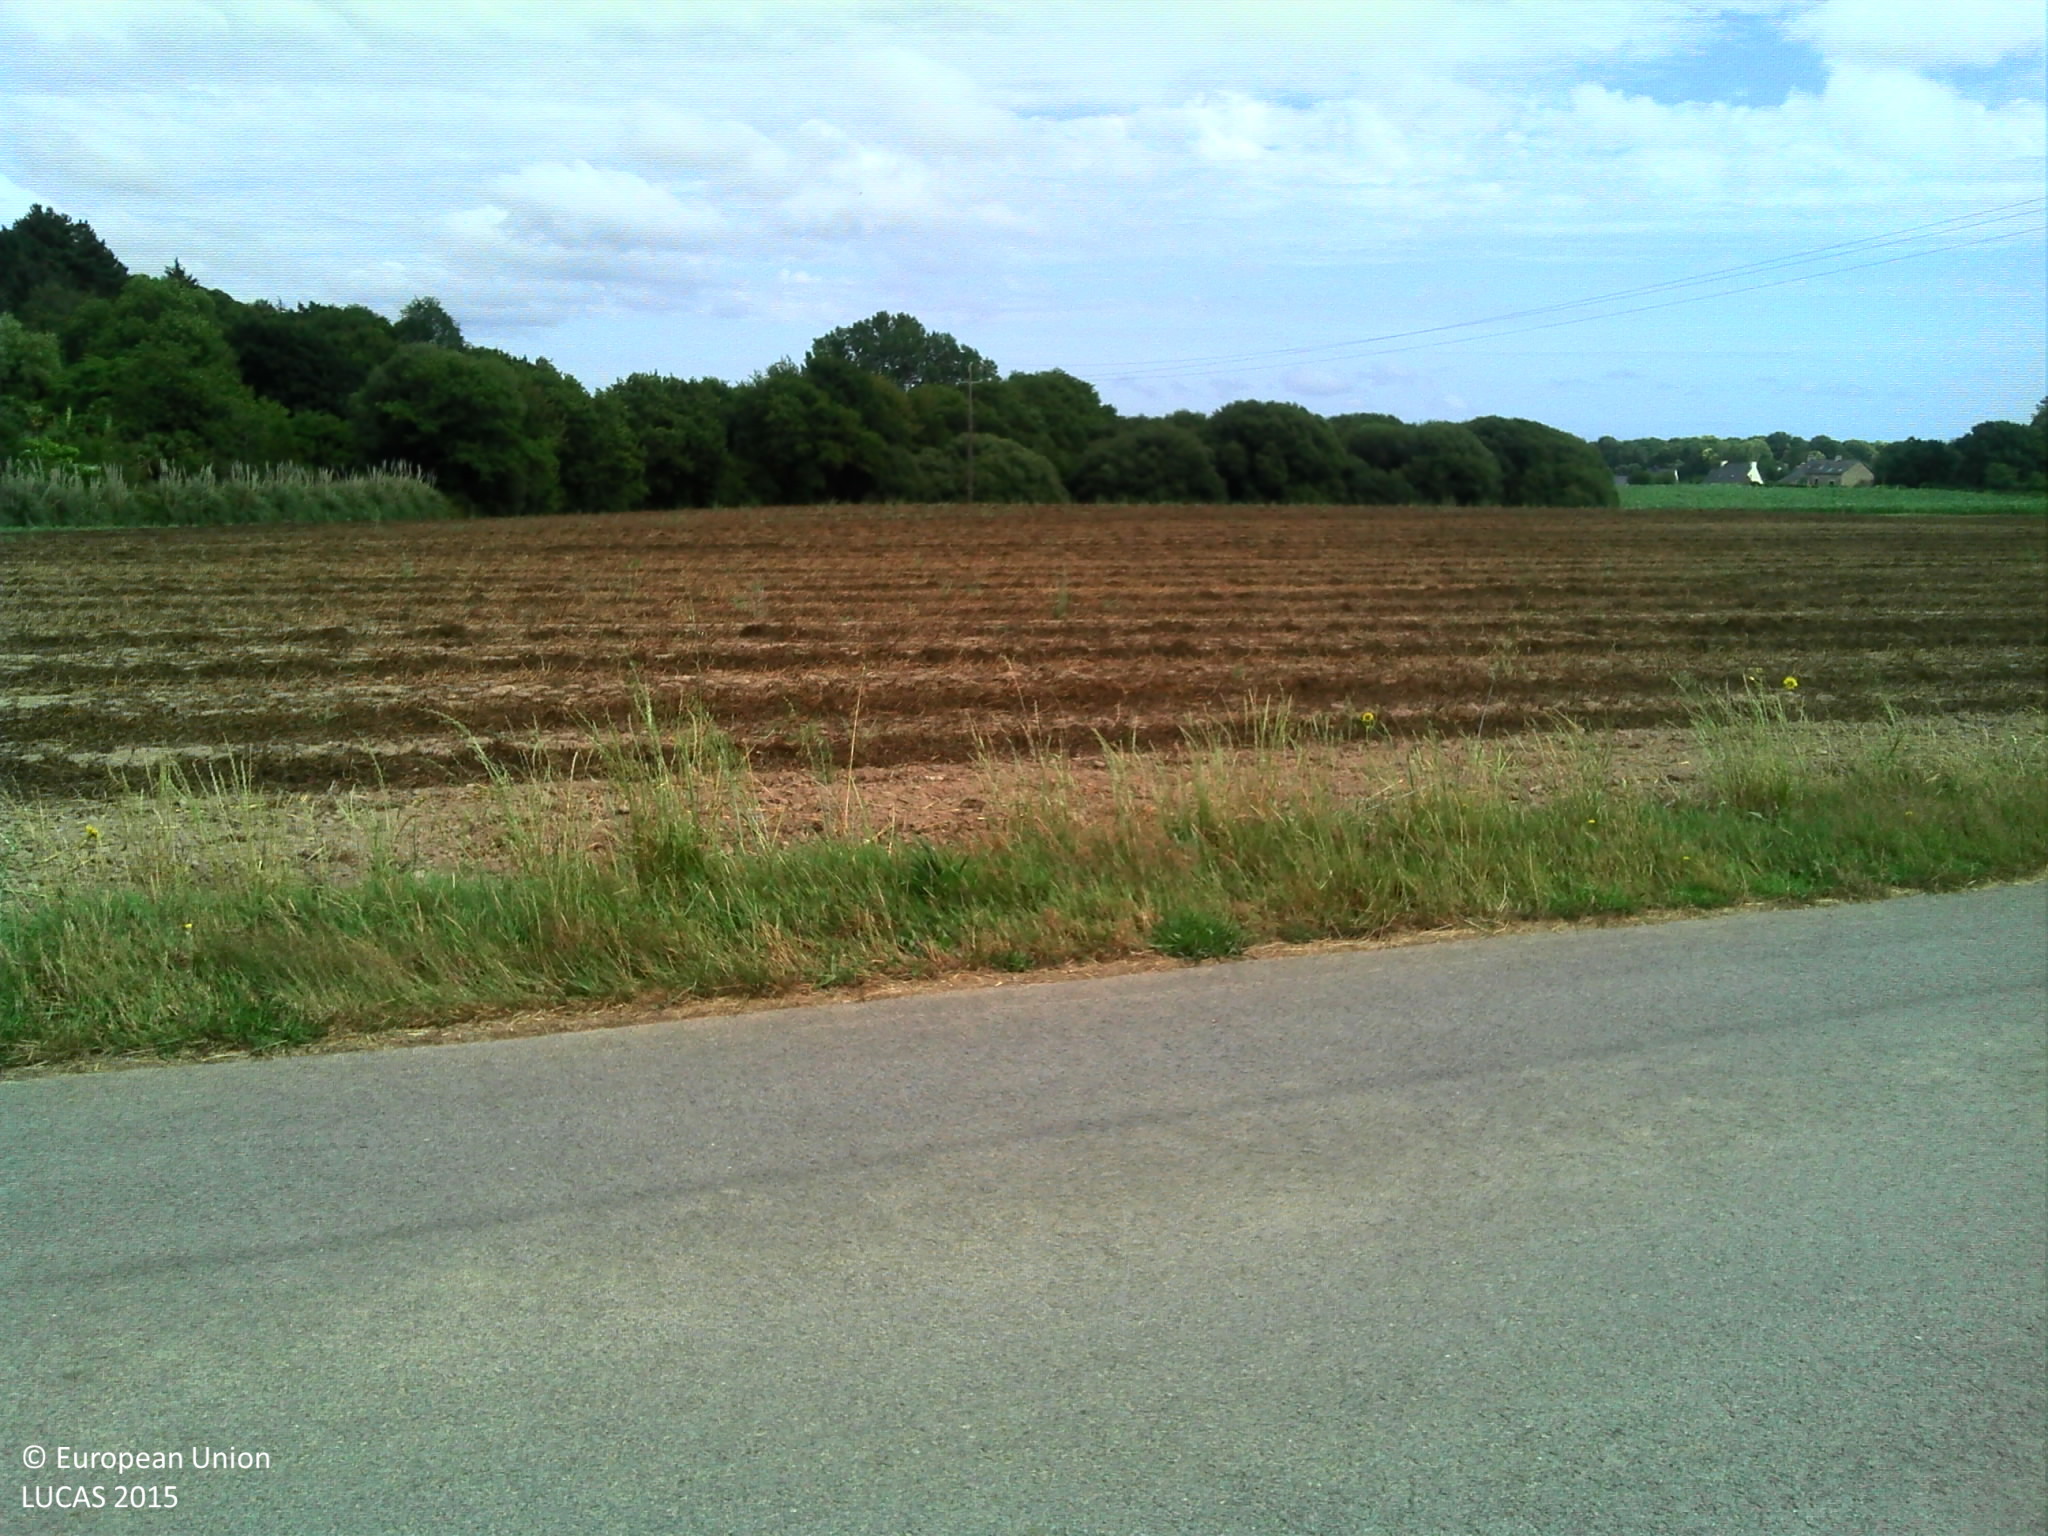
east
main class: Cropland
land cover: Common wheat
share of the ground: > 75 %
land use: Agriculture (excluding fallow land and kitchen gardens)
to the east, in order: Common wheat; Electric lines; Grass margins; Paved roads, cycling and walking lanes; Grass margins; Oats; Grassland without tree/shrub cover; Broadleaved woodland; Ditches and canals; Grassland without tree/shrub cover; Inland fresh water bodies; Grassland without tree/shrub cover; Inland fresh water bodies; Spontaneously vegetated surfaces; Paved roads, cycling and walking lanes
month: July
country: FR
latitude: 47.8229
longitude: -3.5267
